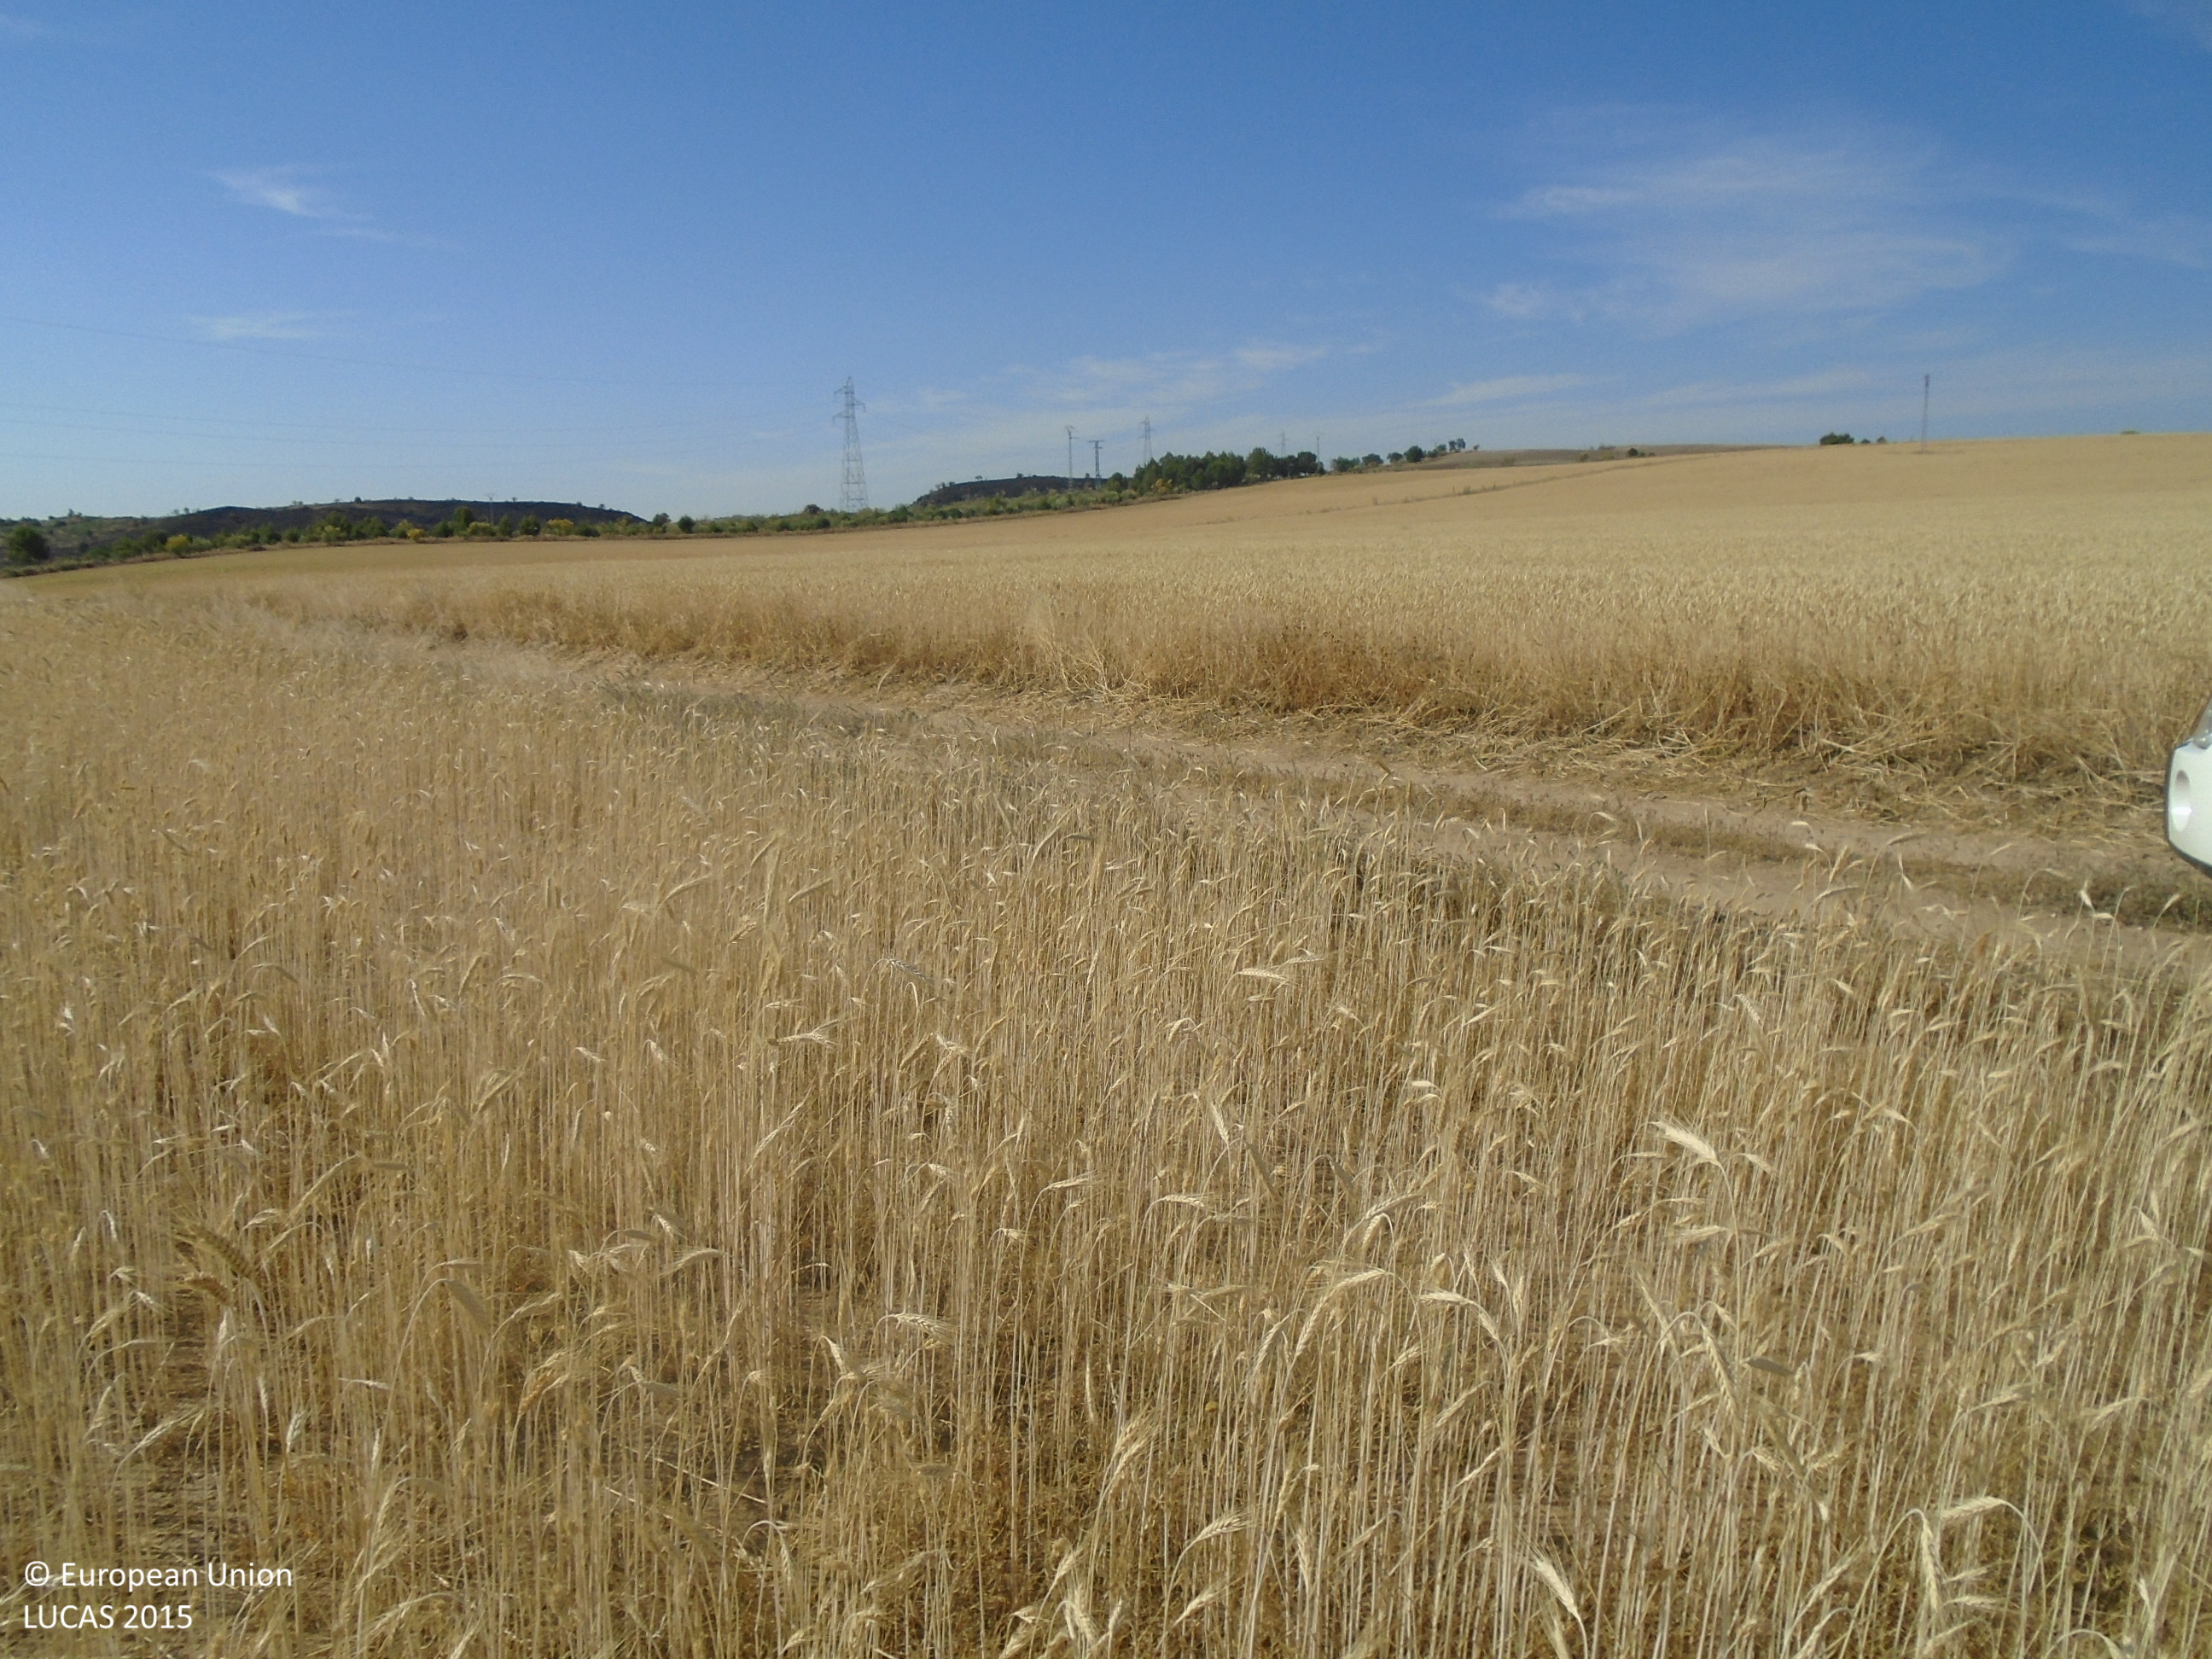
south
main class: Cropland
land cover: Triticale
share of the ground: > 75 %
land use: Agriculture (excluding fallow land and kitchen gardens)
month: June
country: ES
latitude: 39.8389
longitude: -3.7851
